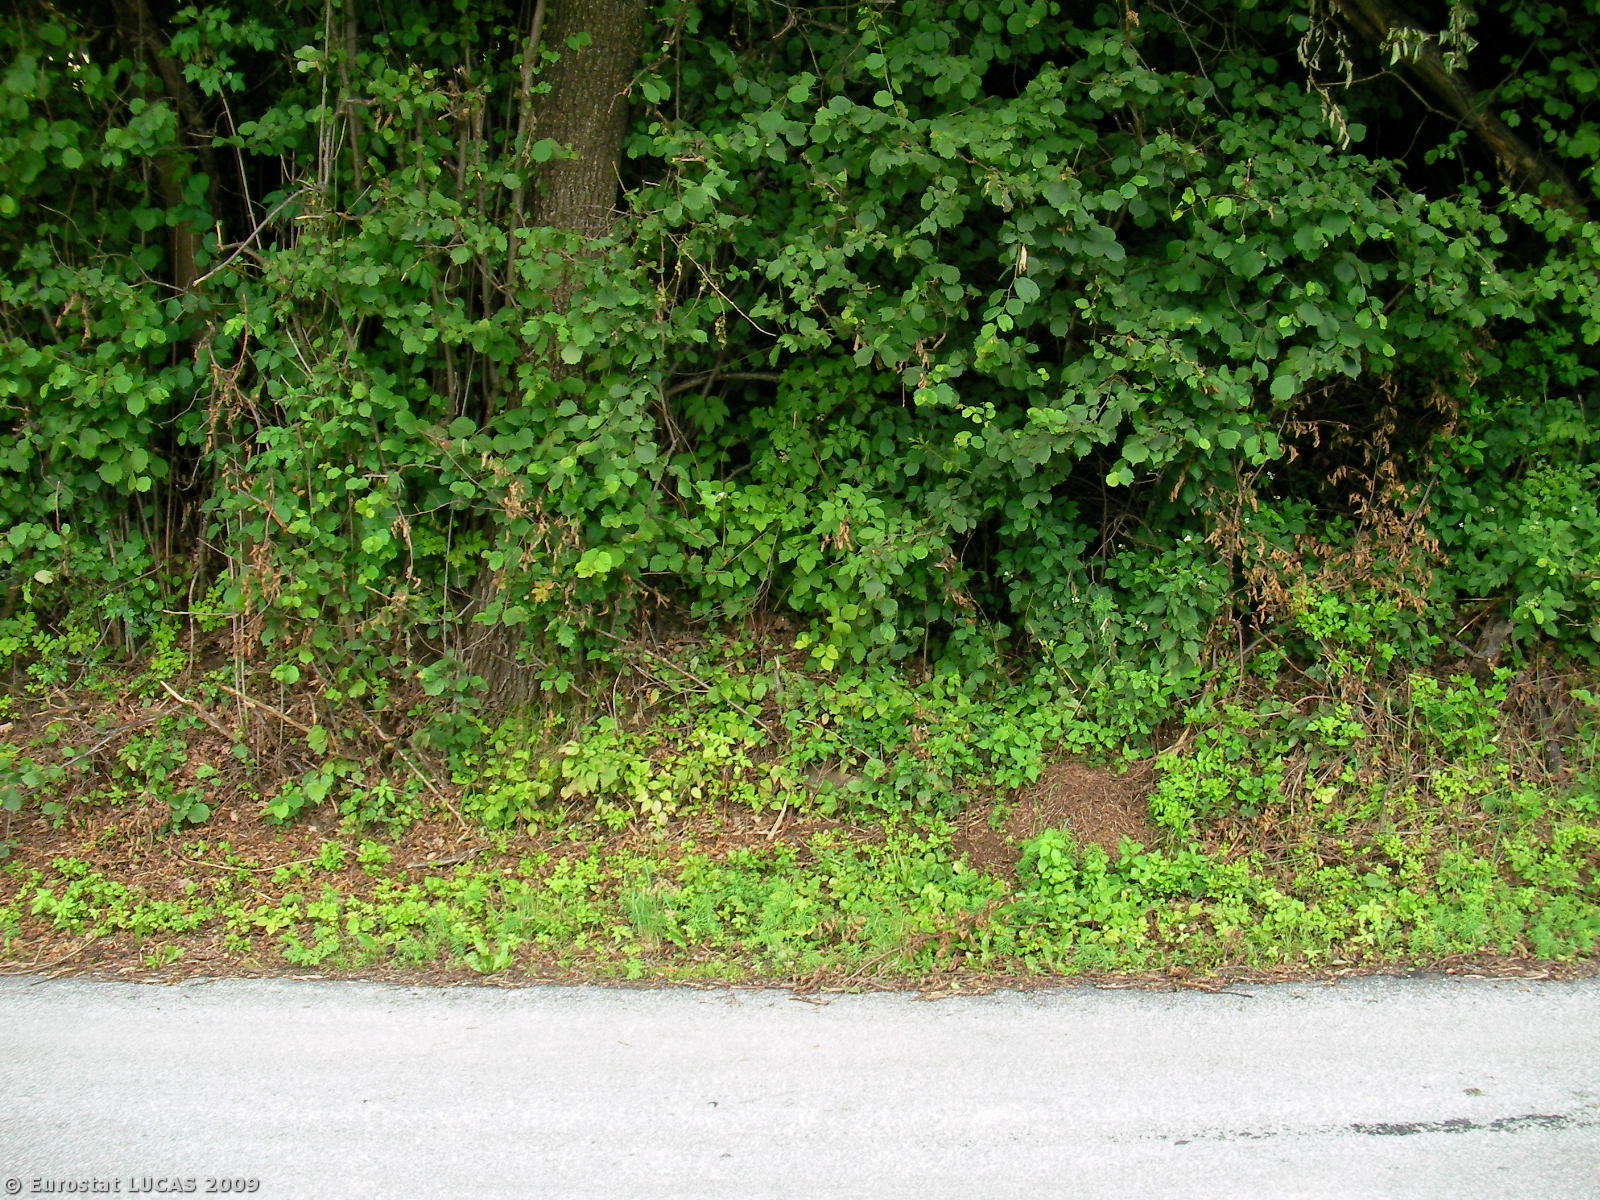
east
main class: Grassland
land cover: Grassland without tree/shrub cover
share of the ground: > 75 %
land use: Agriculture (excluding fallow land and kitchen gardens)
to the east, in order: Grassland without tree/shrub cover; Fences; Grassland without tree/shrub cover; Paved roads, cycling and walking lanes; Broadleaved woodland; Electric lines; Grass margins; Paved roads, cycling and walking lanes; Grass margins; Fences; Grassland without tree/shrub cover; Fences; Coniferous woodland
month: July
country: AT
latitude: 47.2257
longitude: 15.7458
